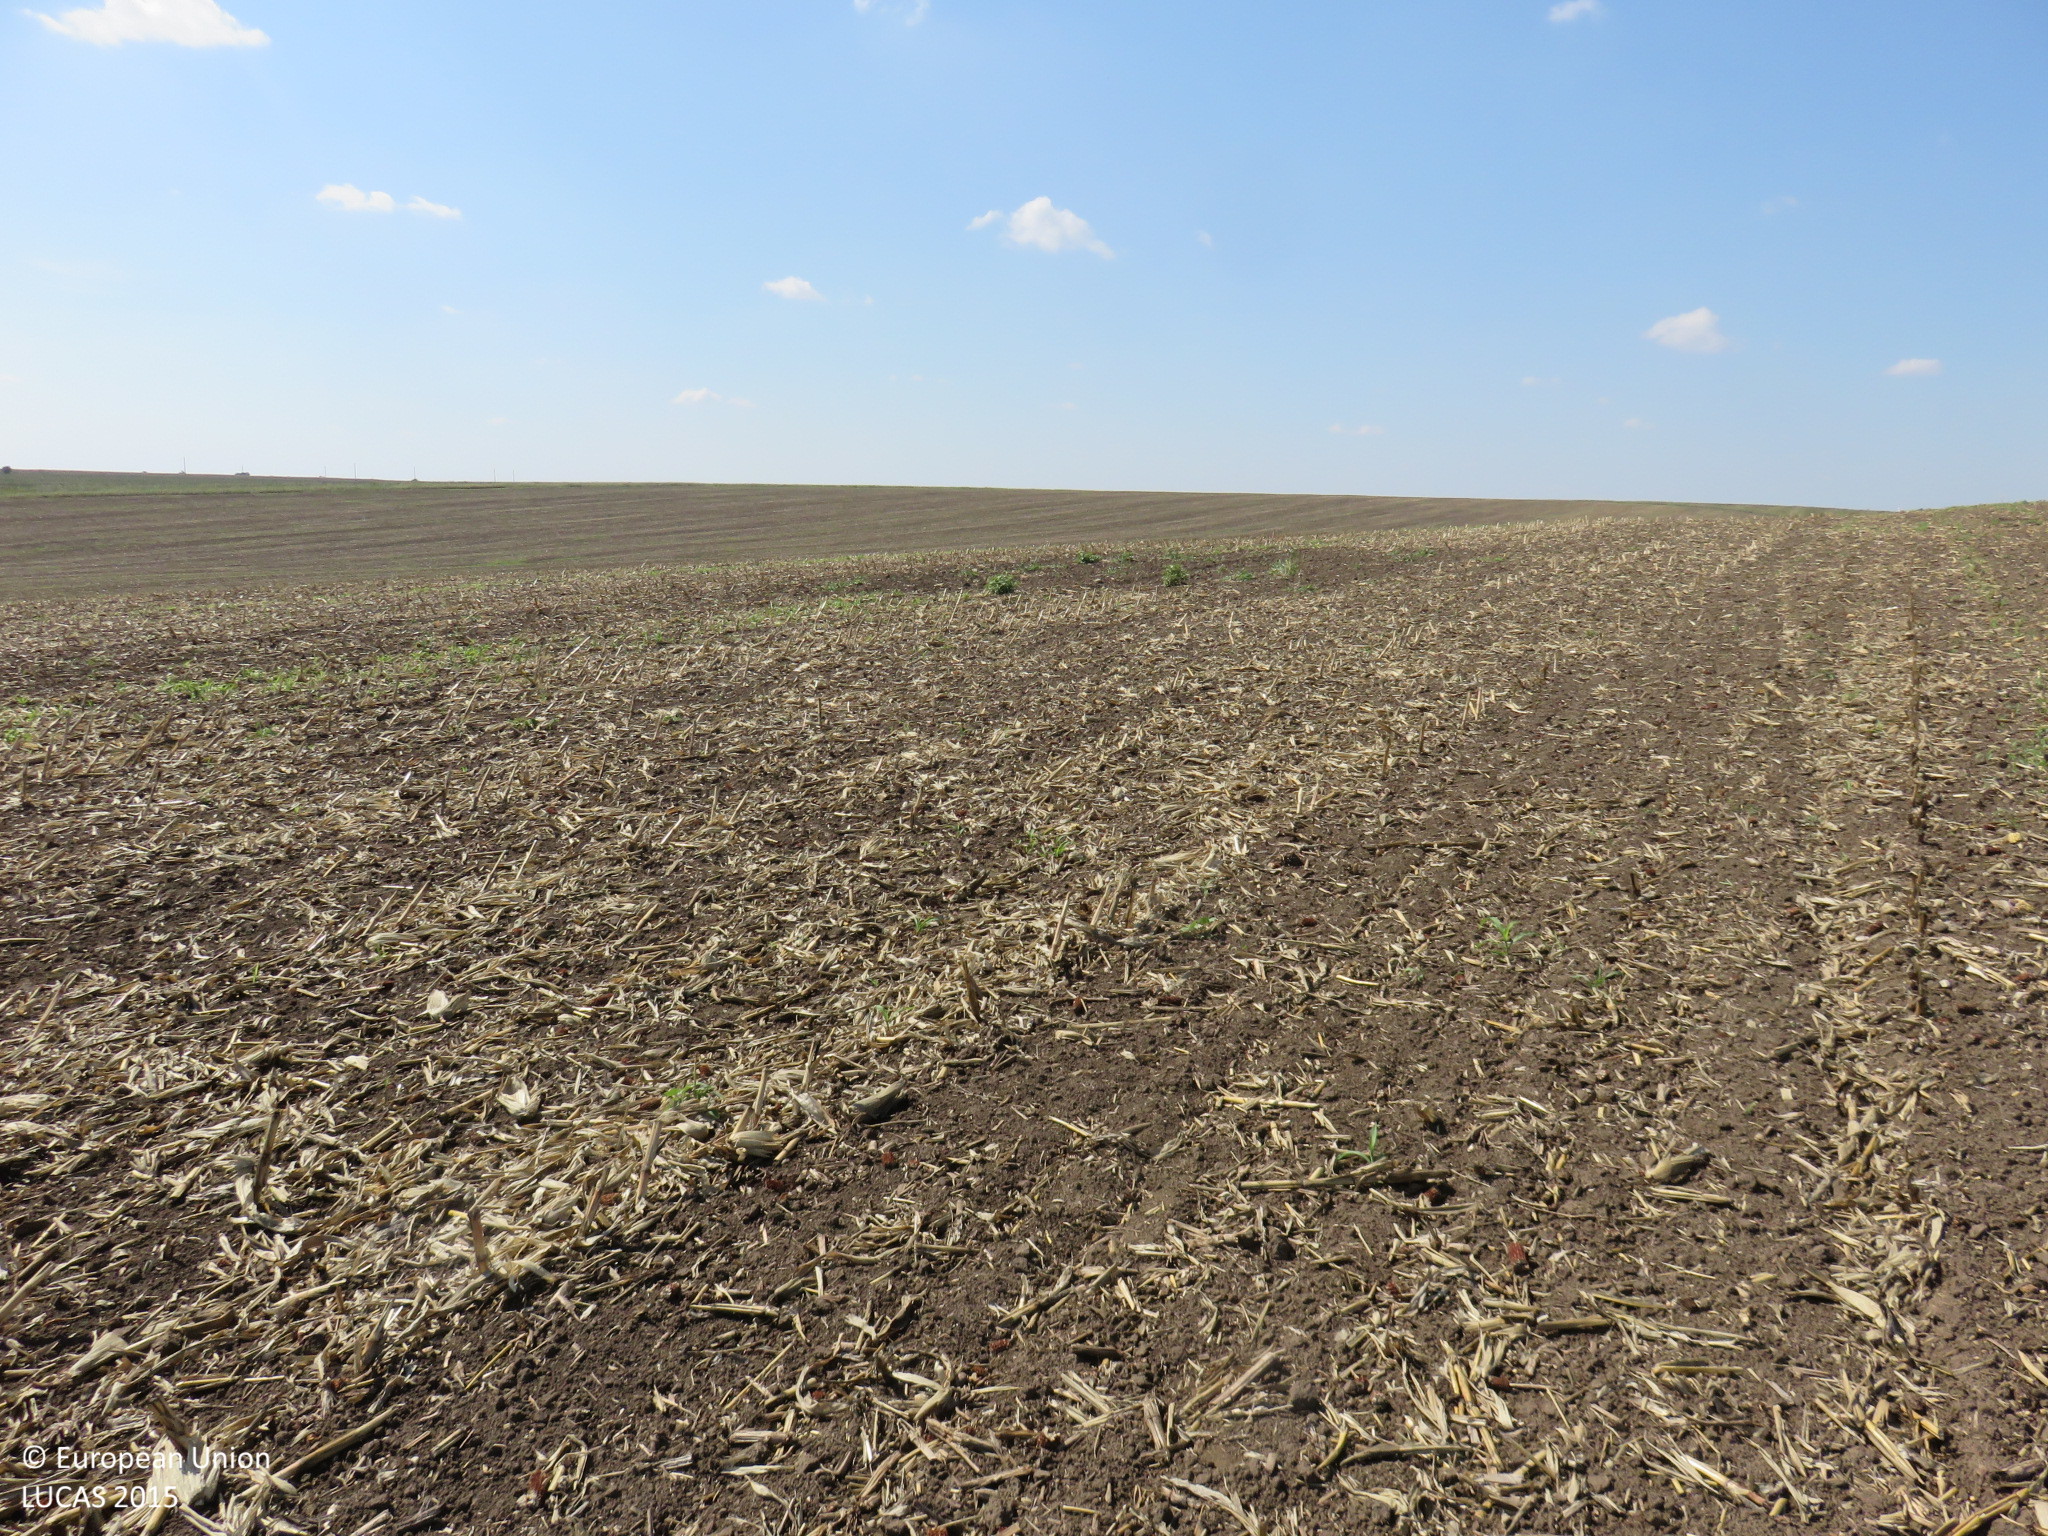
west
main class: Cropland
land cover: Maize
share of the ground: > 75 %
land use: Agriculture (excluding fallow land and kitchen gardens)
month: September
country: BG
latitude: 43.6187
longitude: 24.4992
